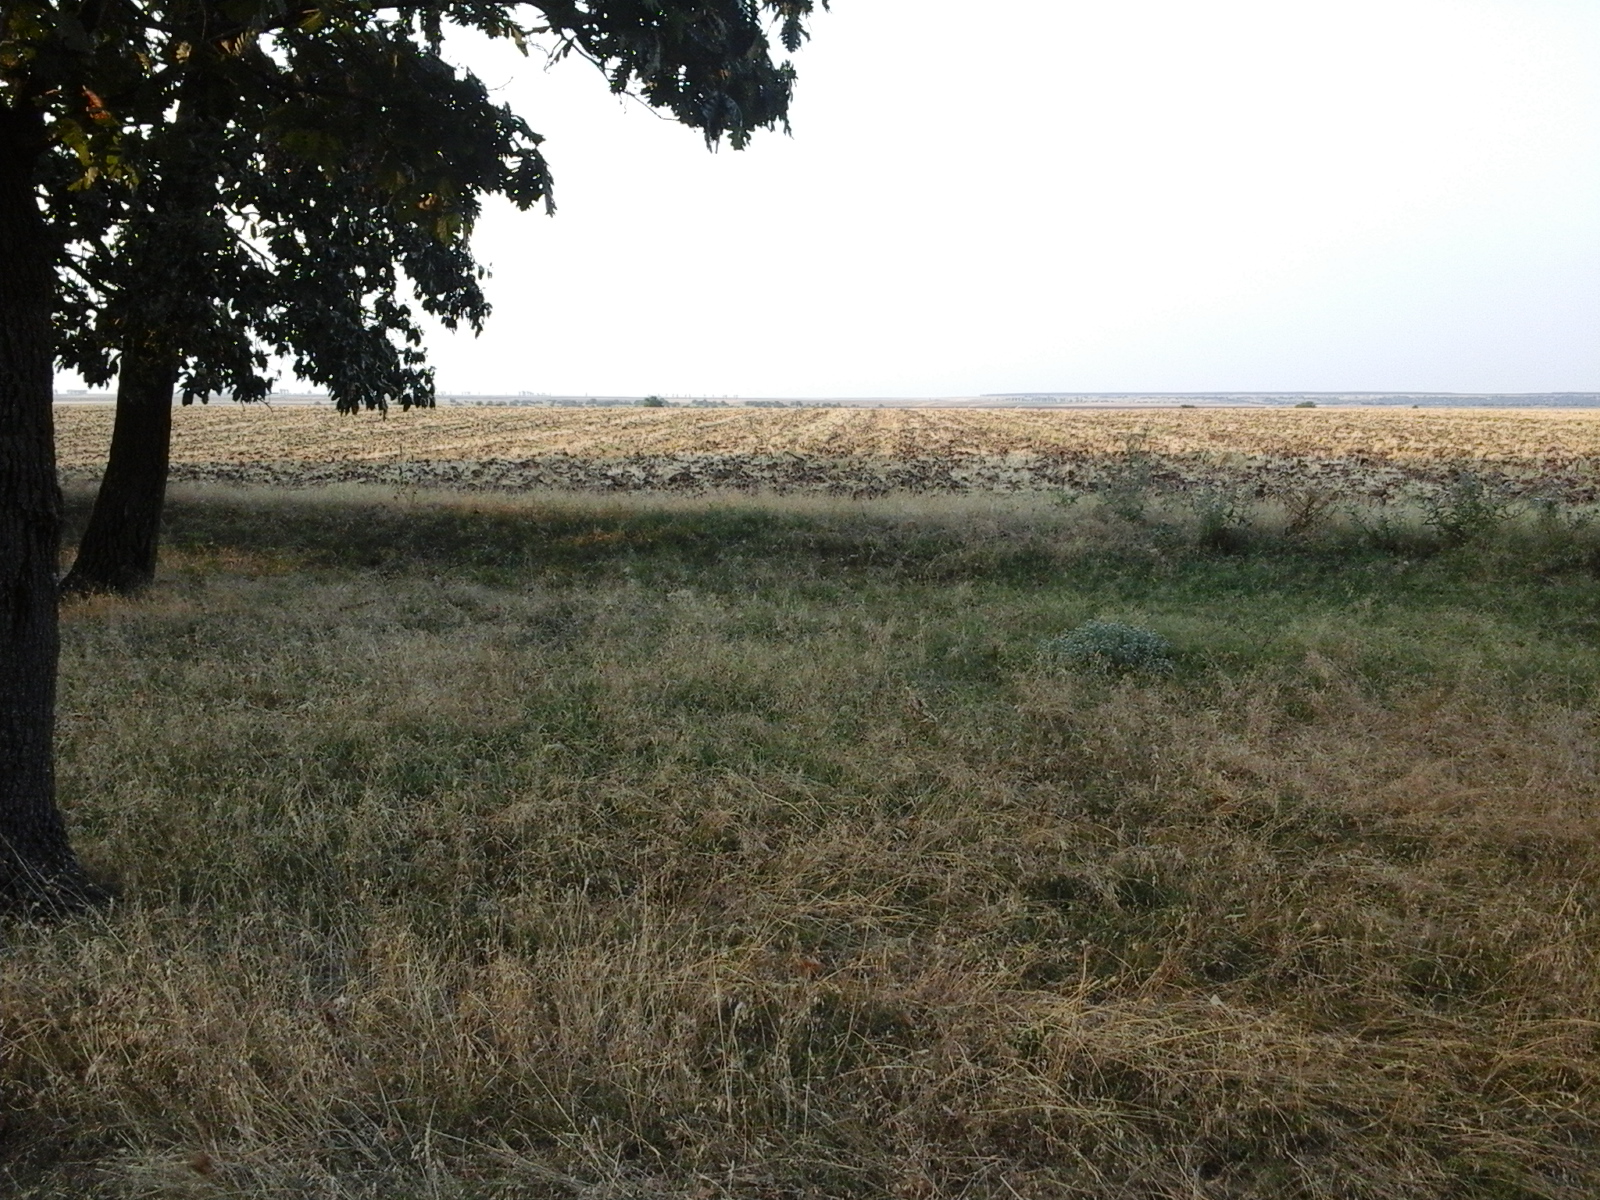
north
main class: Woodland
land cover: Broadleaved woodland
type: acidophilous oak and oak-birch forest
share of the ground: > 75 %
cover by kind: broadleaved forest trees 100 %
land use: Forestry
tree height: > 5 m
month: August
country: RO
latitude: 44.1636
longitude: 23.3157
